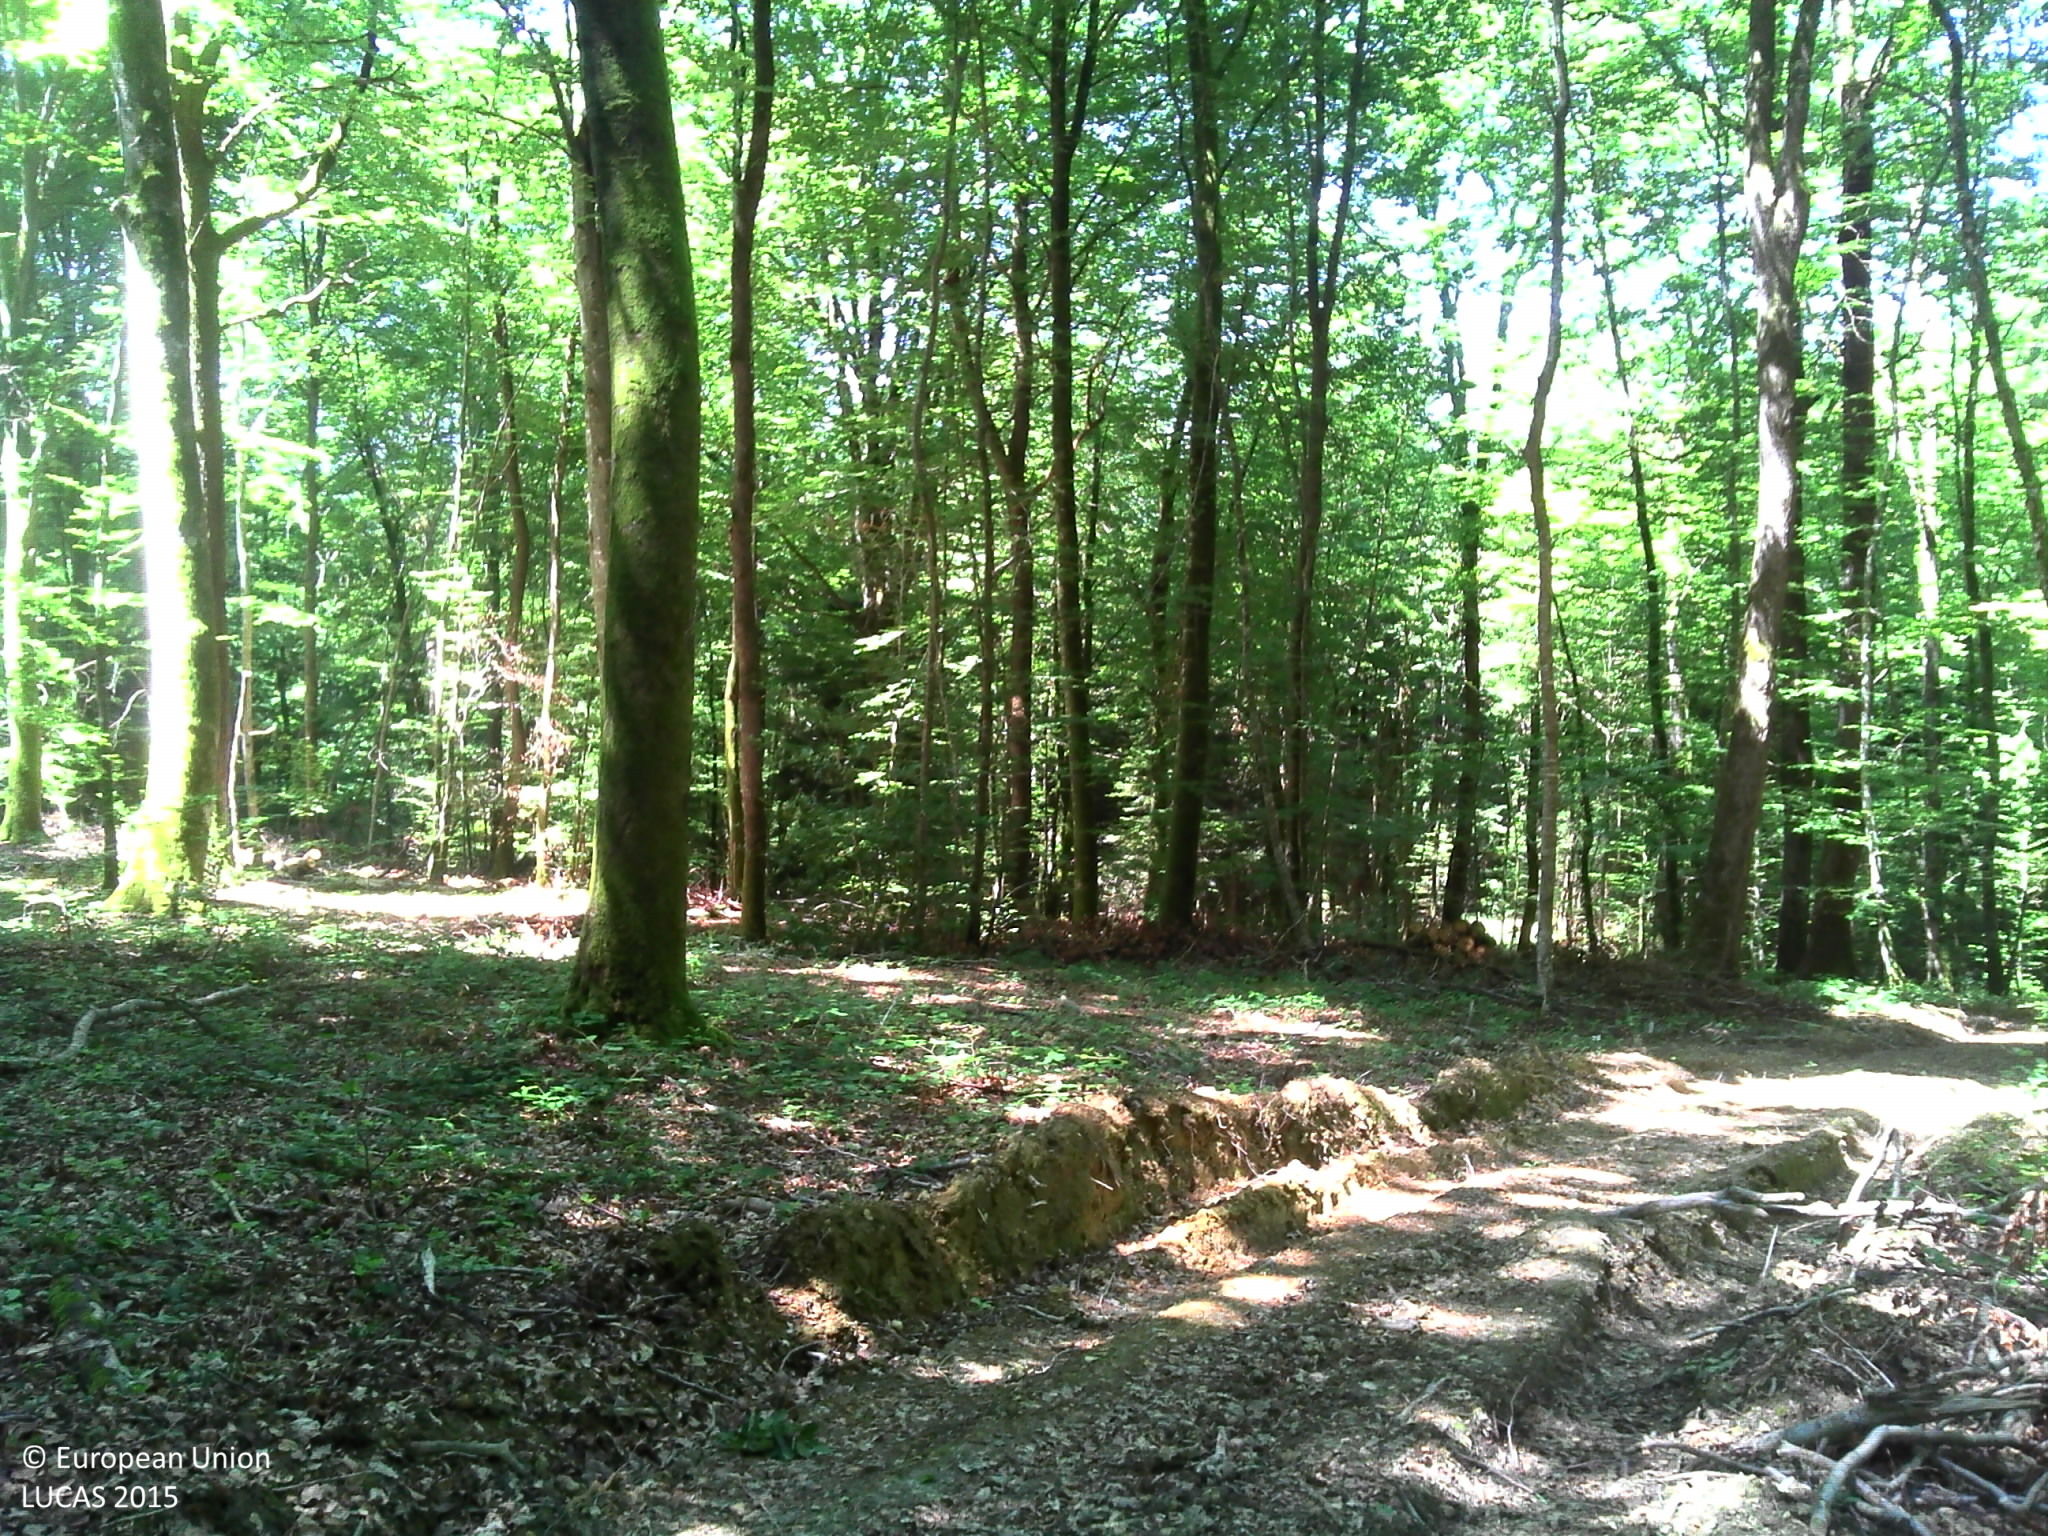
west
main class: Woodland
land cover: Broadleaved woodland
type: beech forest
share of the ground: > 75 %
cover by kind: broadleaved forest trees 90 %, consolidated bare surface 10 %
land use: Forestry
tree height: > 5 m
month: June
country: FR
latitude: 47.4723
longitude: 6.1670
